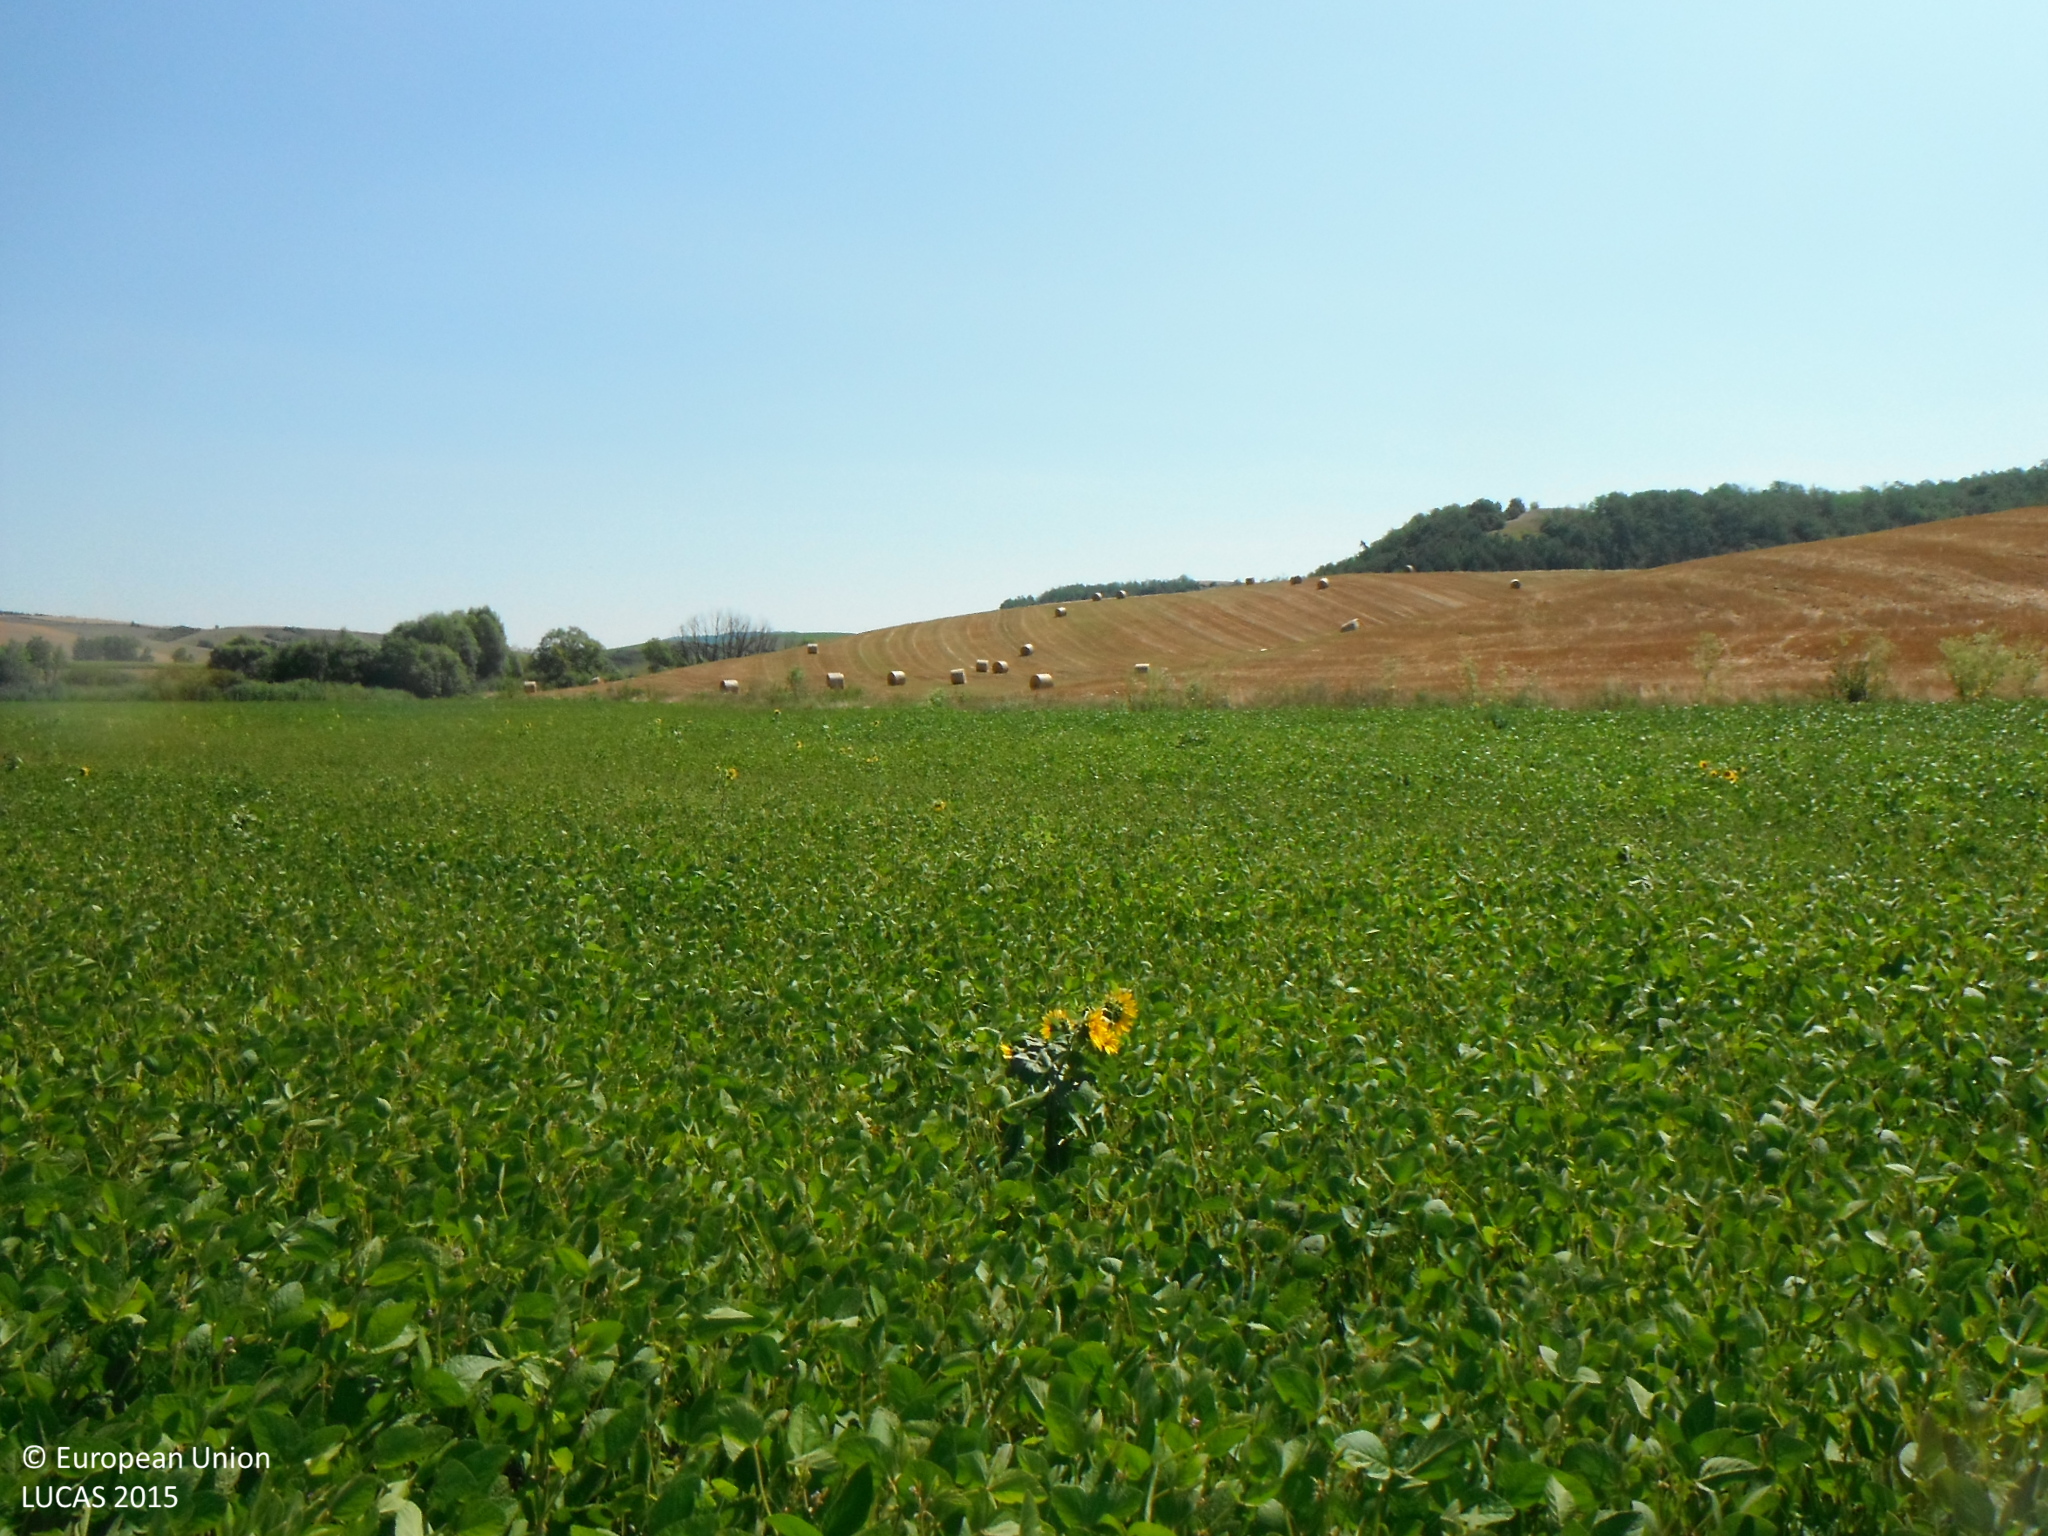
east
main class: Cropland
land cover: Soya
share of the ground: > 75 %
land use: Agriculture (excluding fallow land and kitchen gardens)
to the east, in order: Soya; Grass margins; Tracks; Common wheat
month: July
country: SK
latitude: 48.2361
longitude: 20.0329
